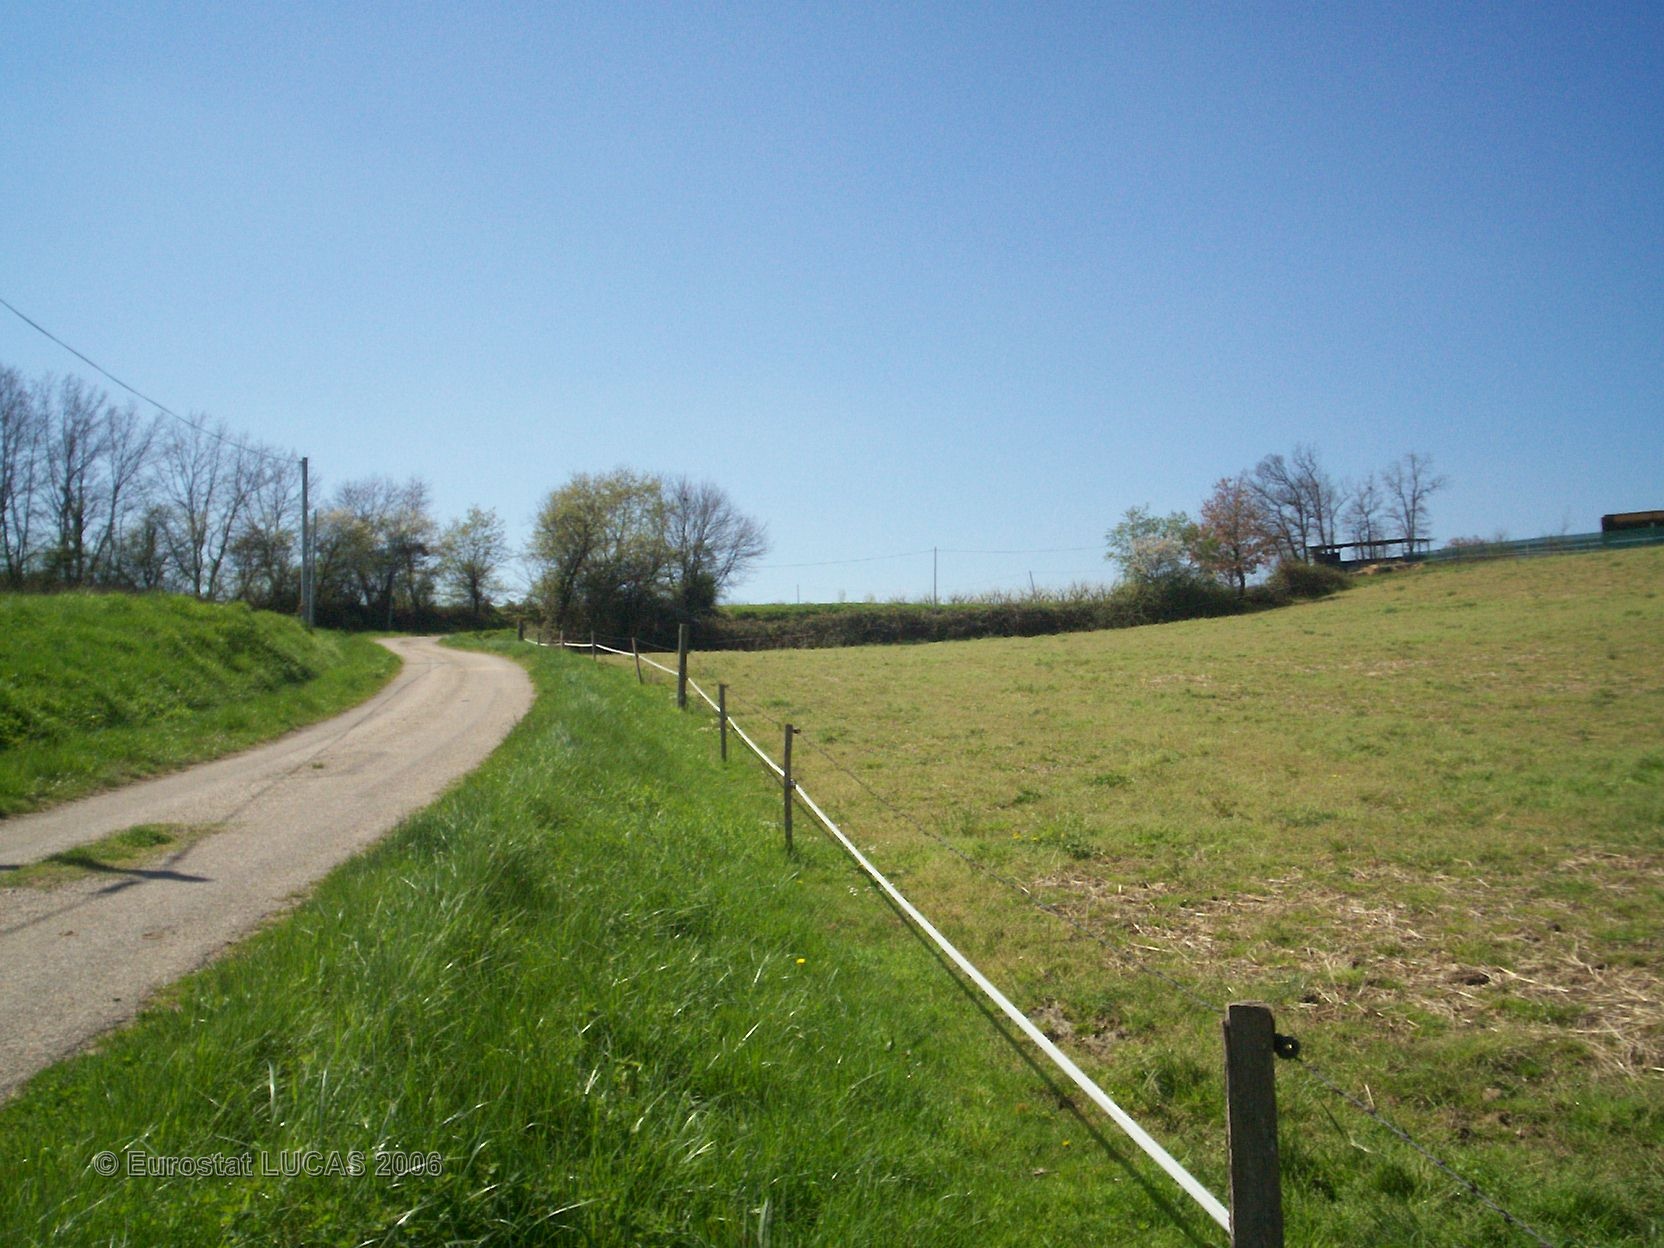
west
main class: Grassland
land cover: Grassland without tree/shrub cover
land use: Agriculture (excluding fallow land and kitchen gardens)
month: April
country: FR
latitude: 44.0250
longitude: 0.9274
